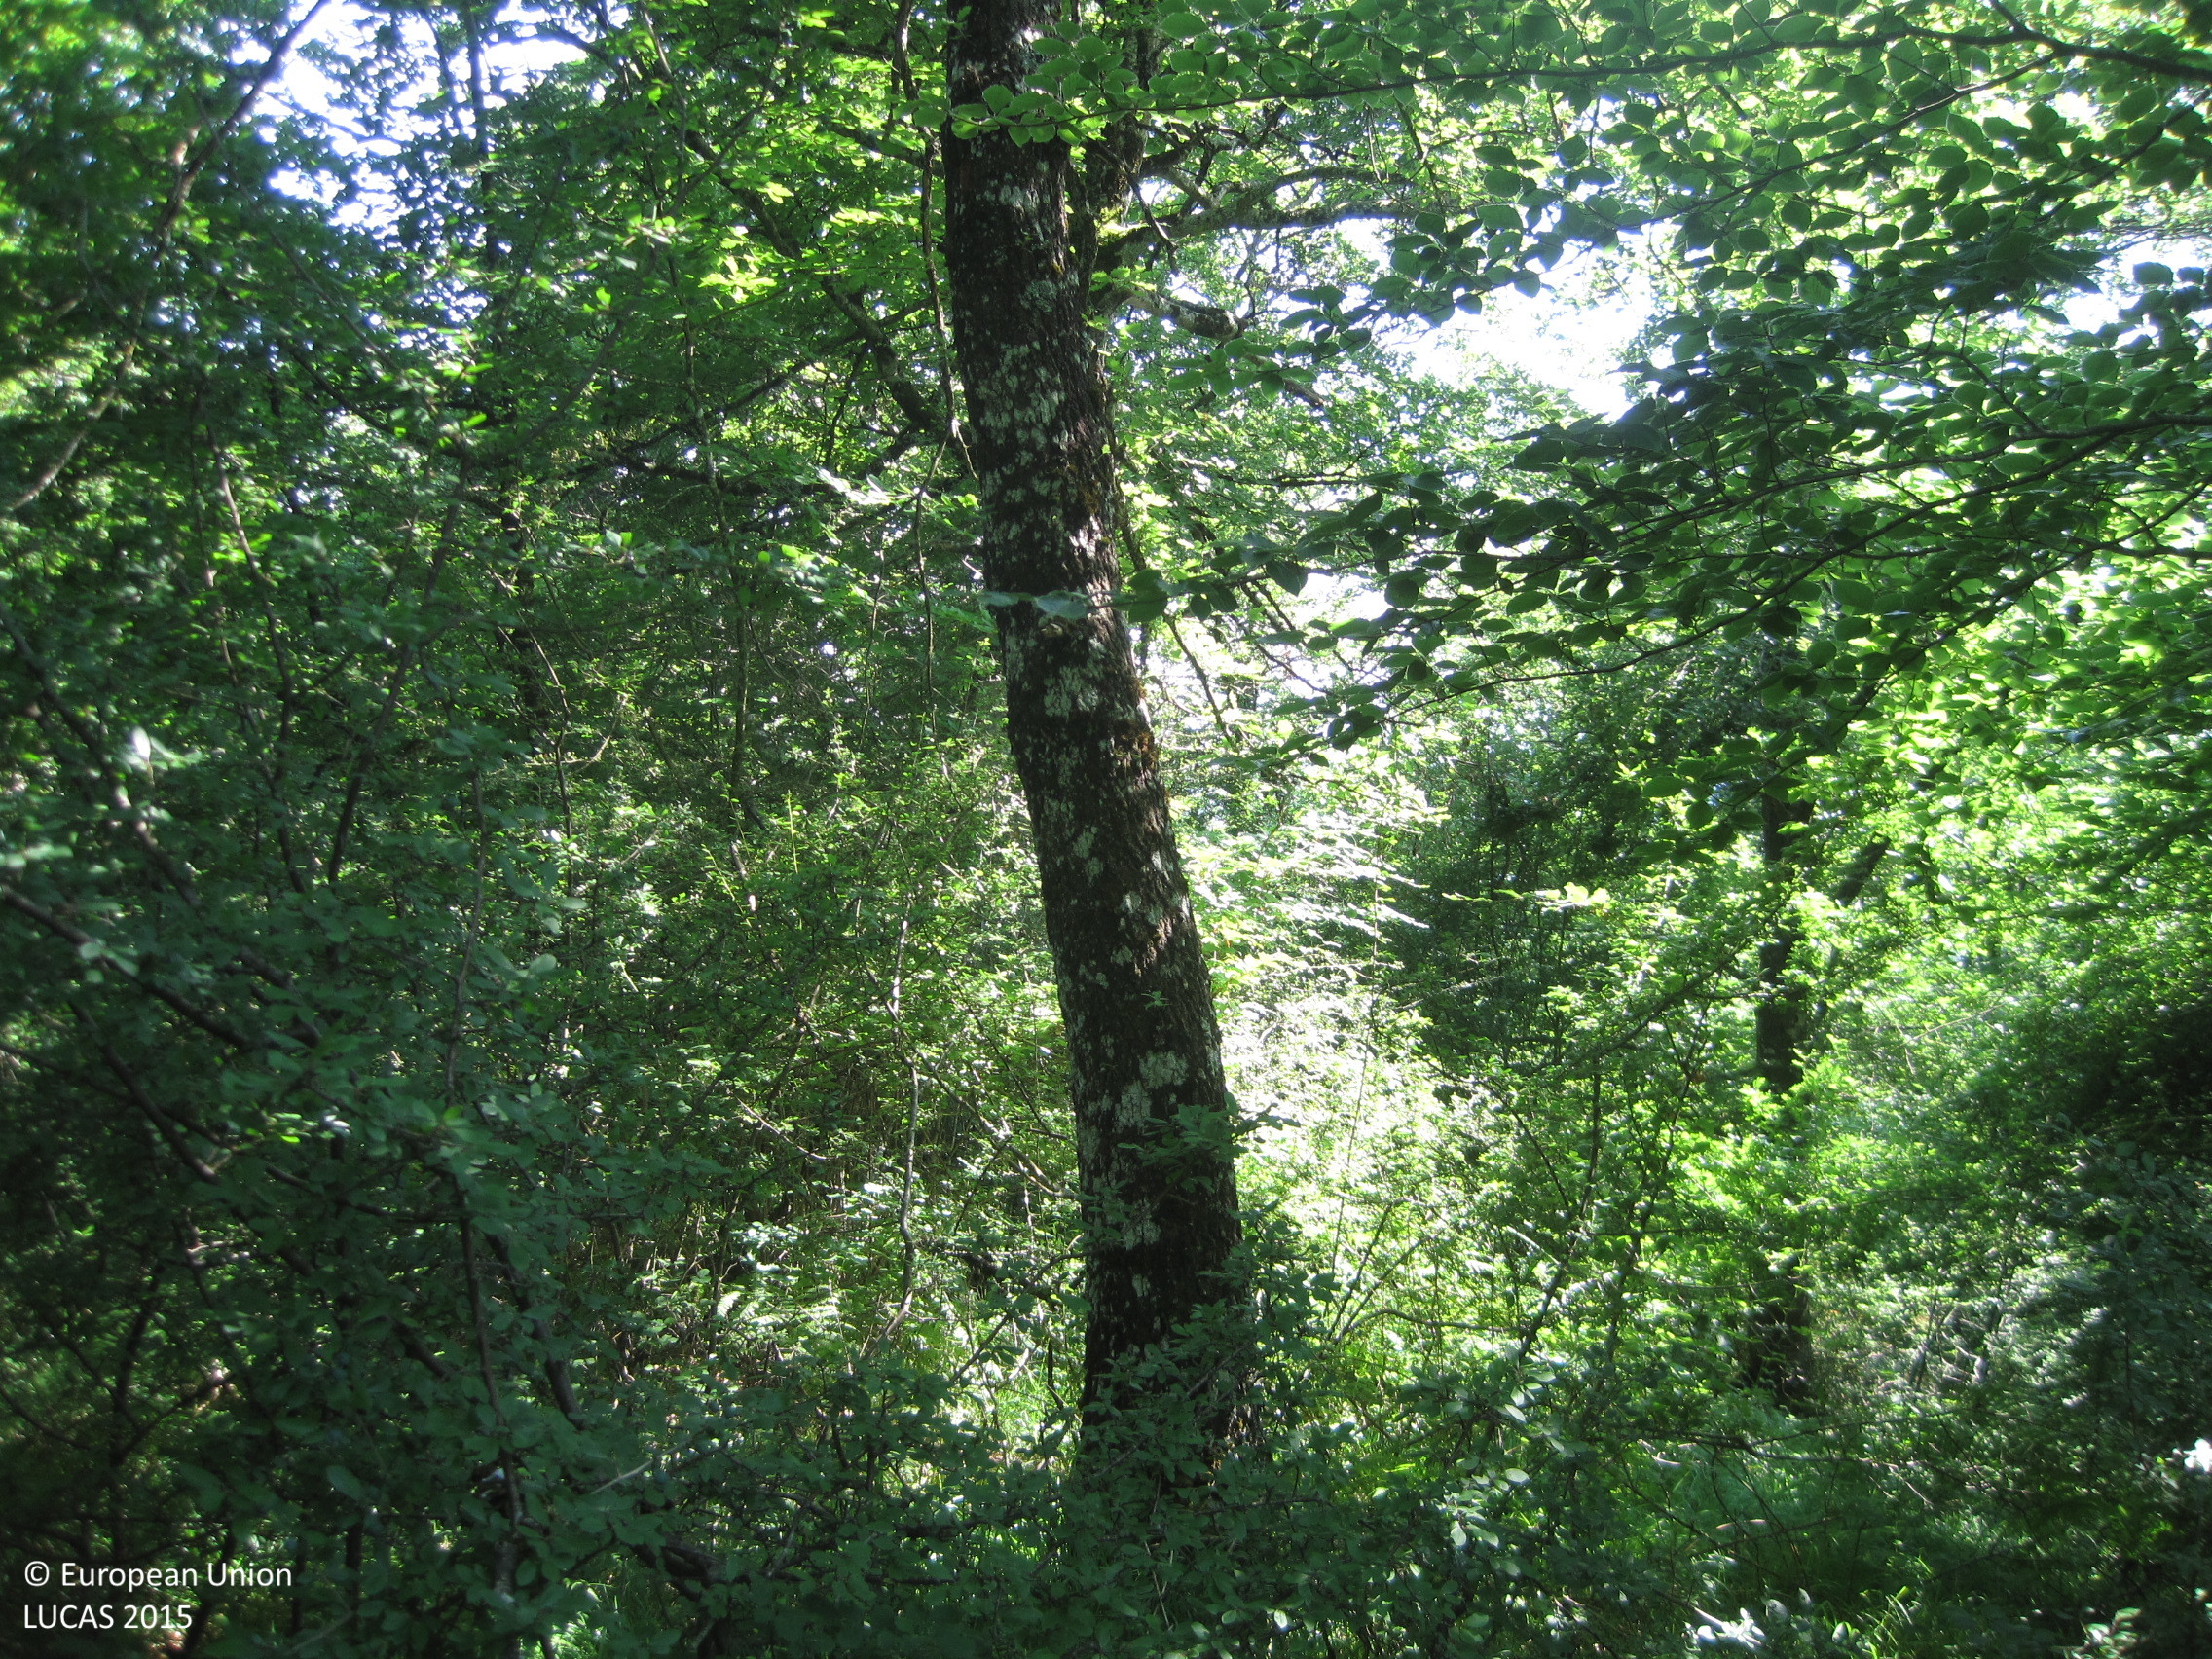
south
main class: Woodland
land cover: Broadleaved woodland
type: beech forest
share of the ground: > 75 %
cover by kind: broadleaved forest trees 100 %
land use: Forestry
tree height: > 5 m
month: June
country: ES
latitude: 42.9288
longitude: -1.7919
